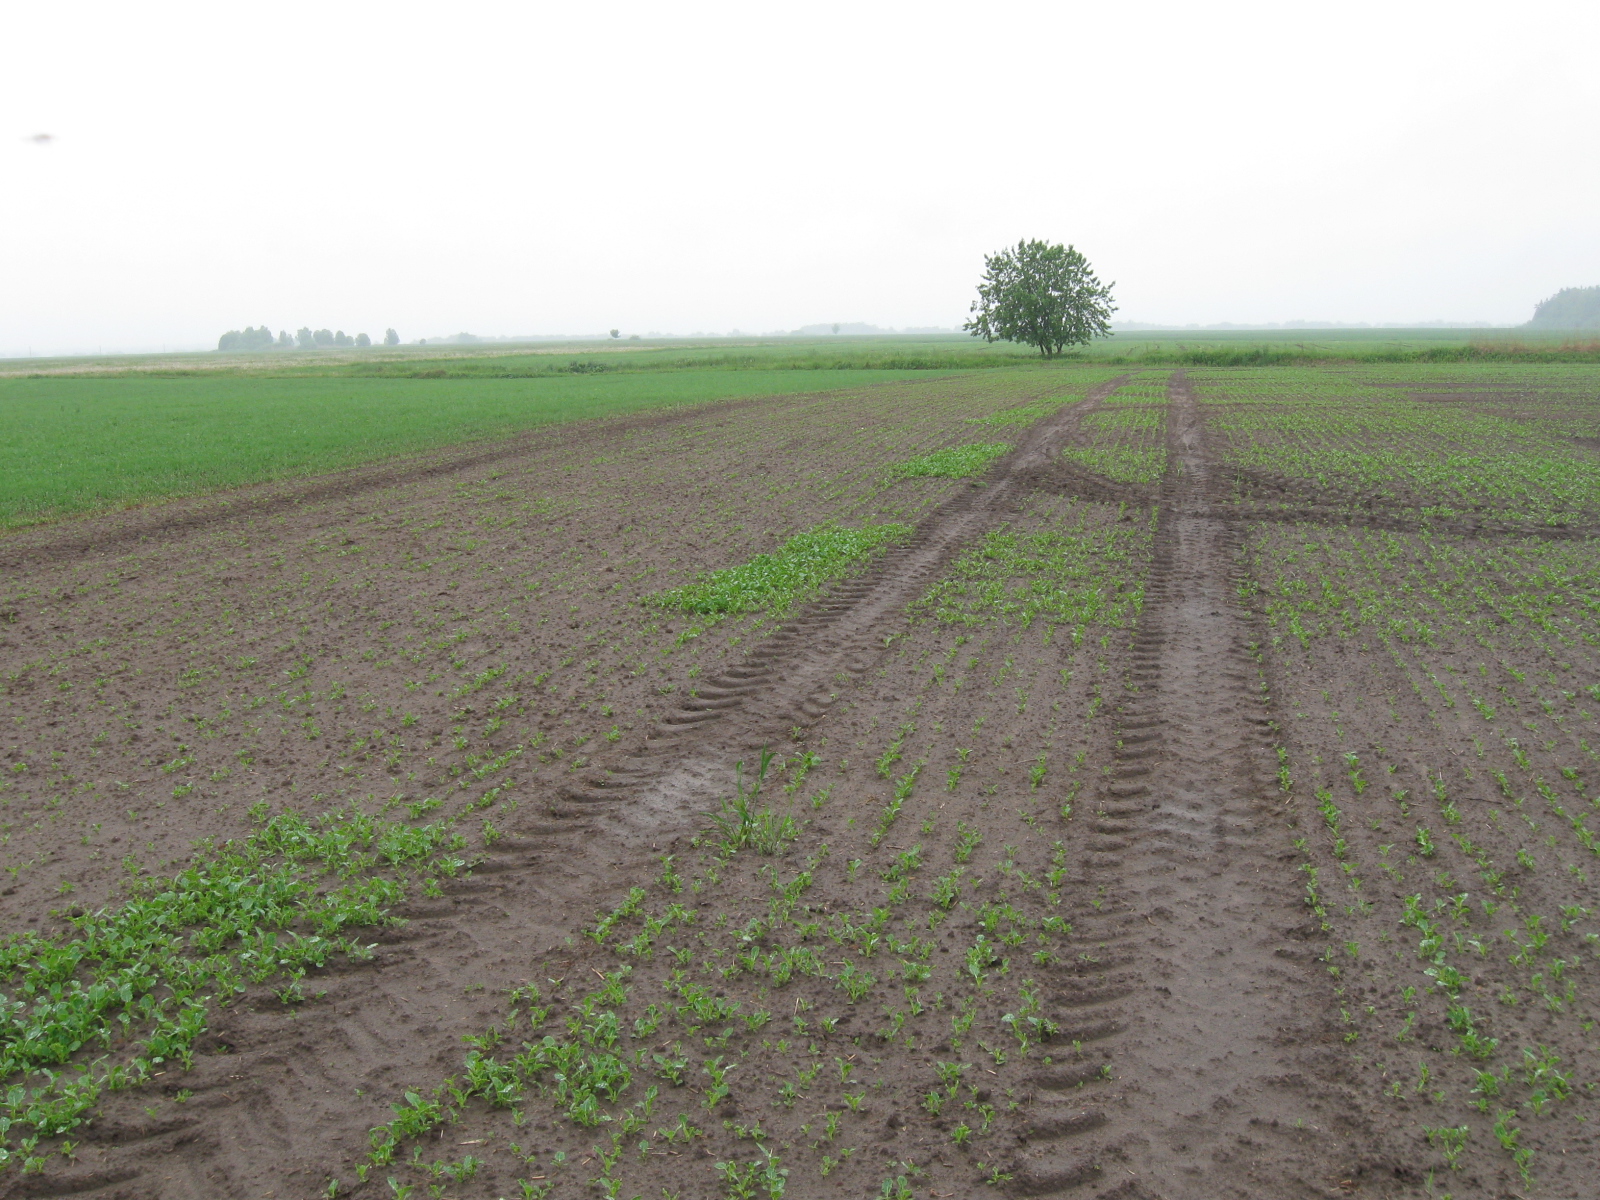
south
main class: Cropland
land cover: Rape and turnip rape
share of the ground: < 10 %
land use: Agriculture (excluding fallow land and kitchen gardens)
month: May
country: LT
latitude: 55.0519
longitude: 22.7934
